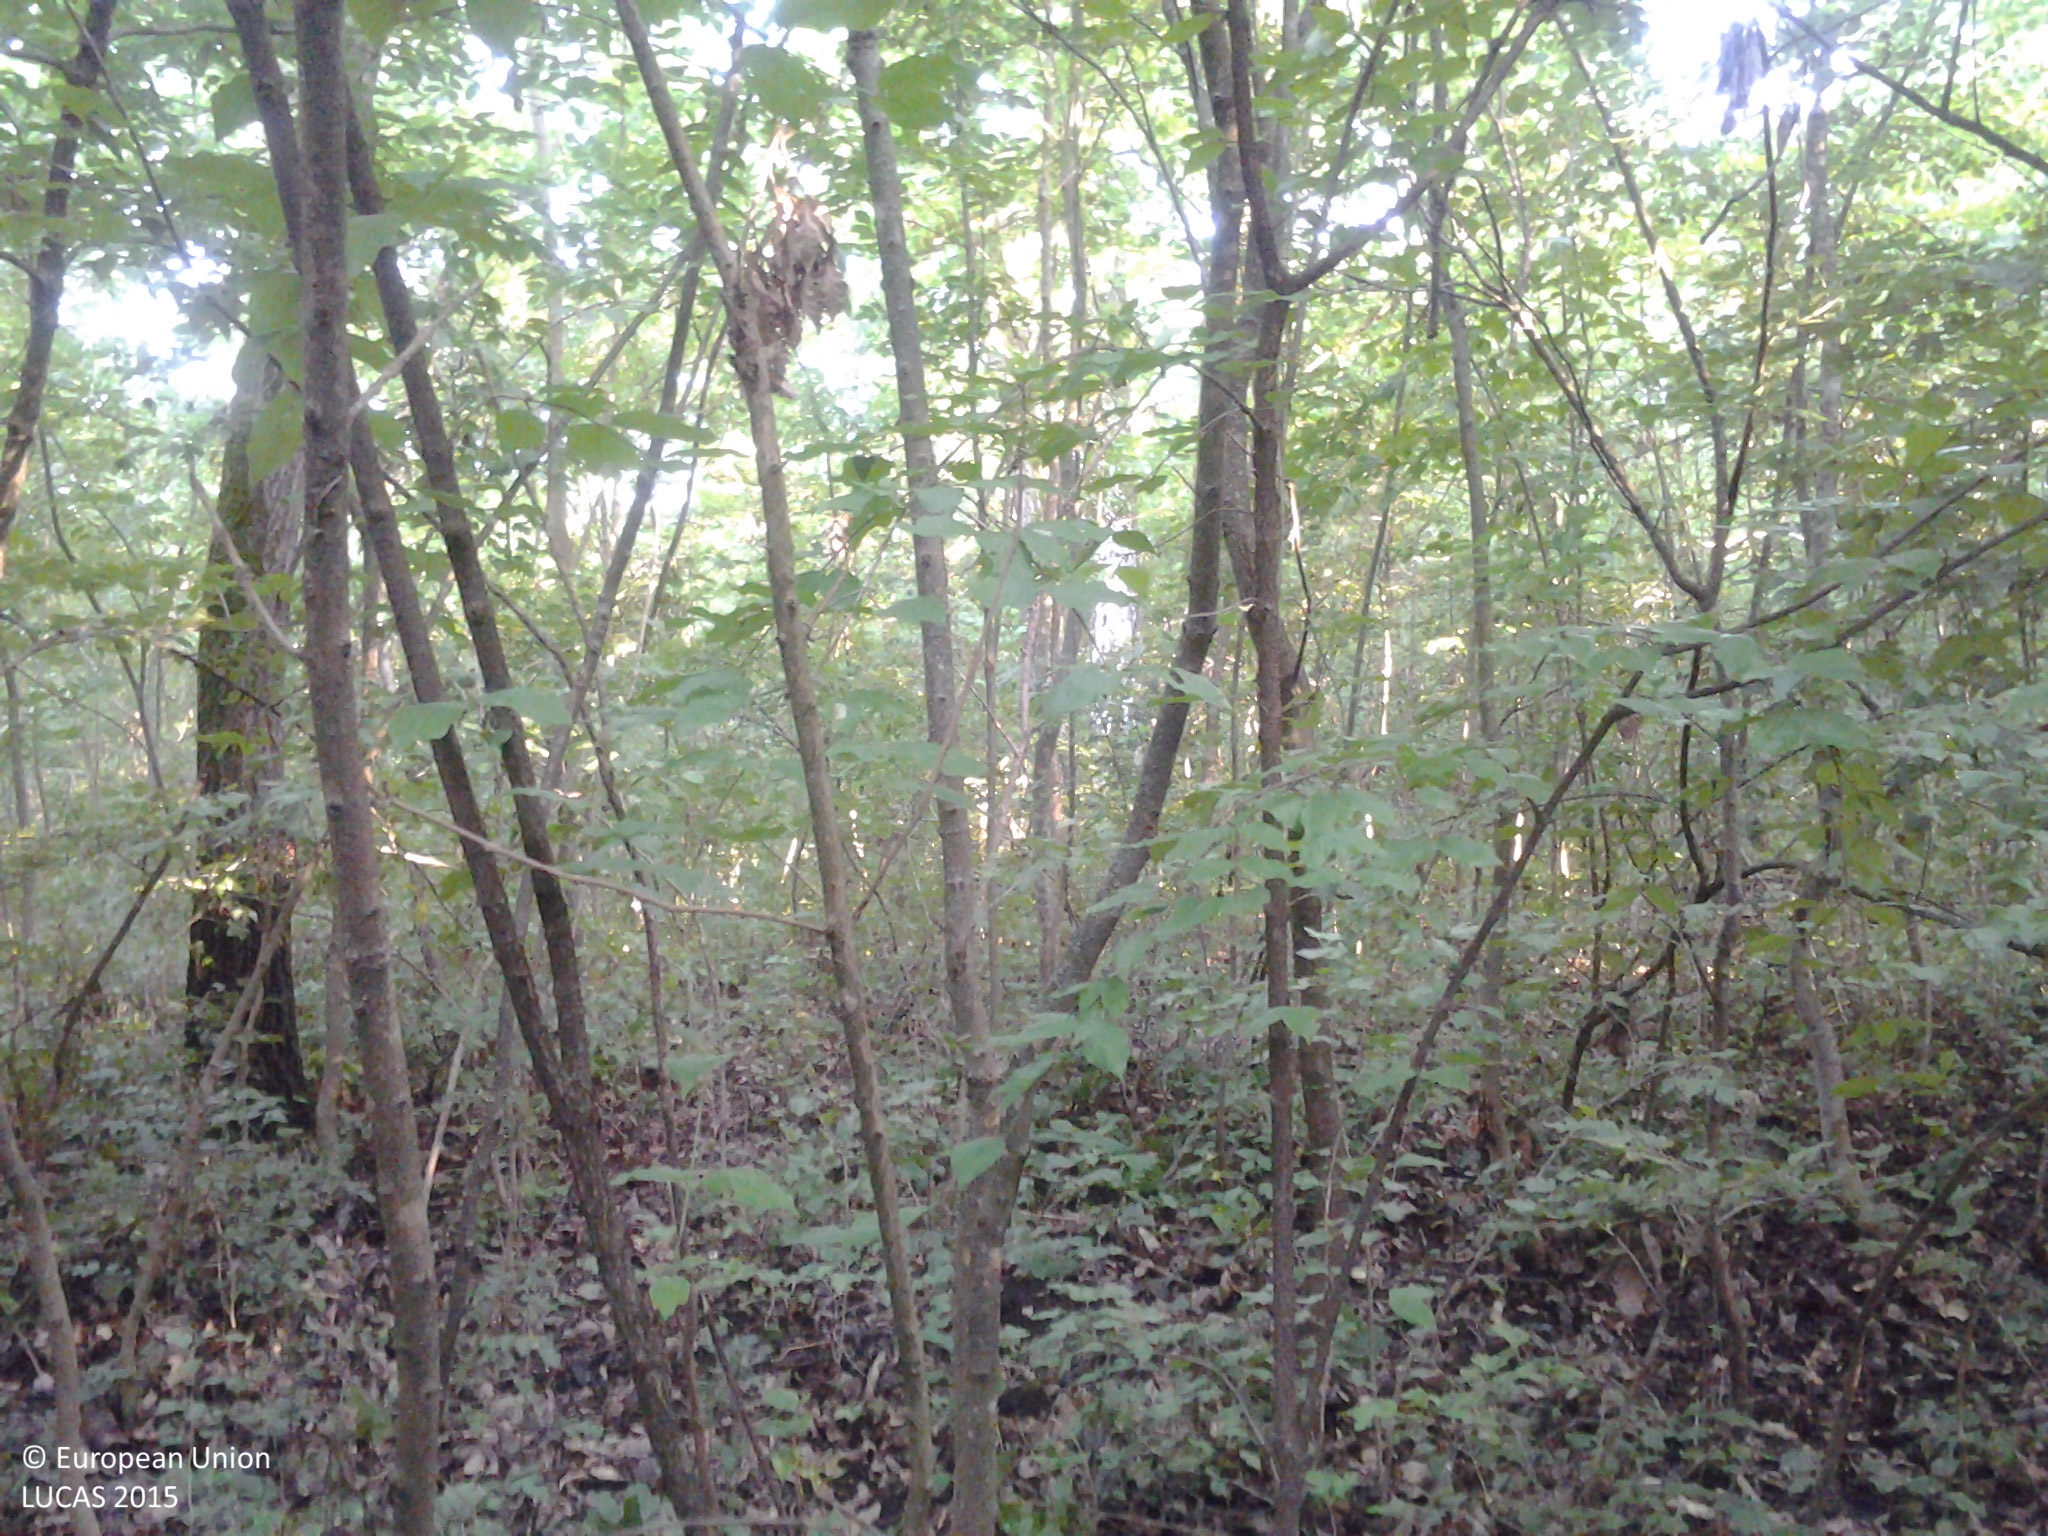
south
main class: Woodland
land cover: Broadleaved woodland
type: mesophytic deciduous forest
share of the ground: > 75 %
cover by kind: broadleaved forest trees 100 %
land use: Forestry
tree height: > 5 m
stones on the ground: 10 - 25 %
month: June
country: RO
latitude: 44.1595
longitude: 26.1465
